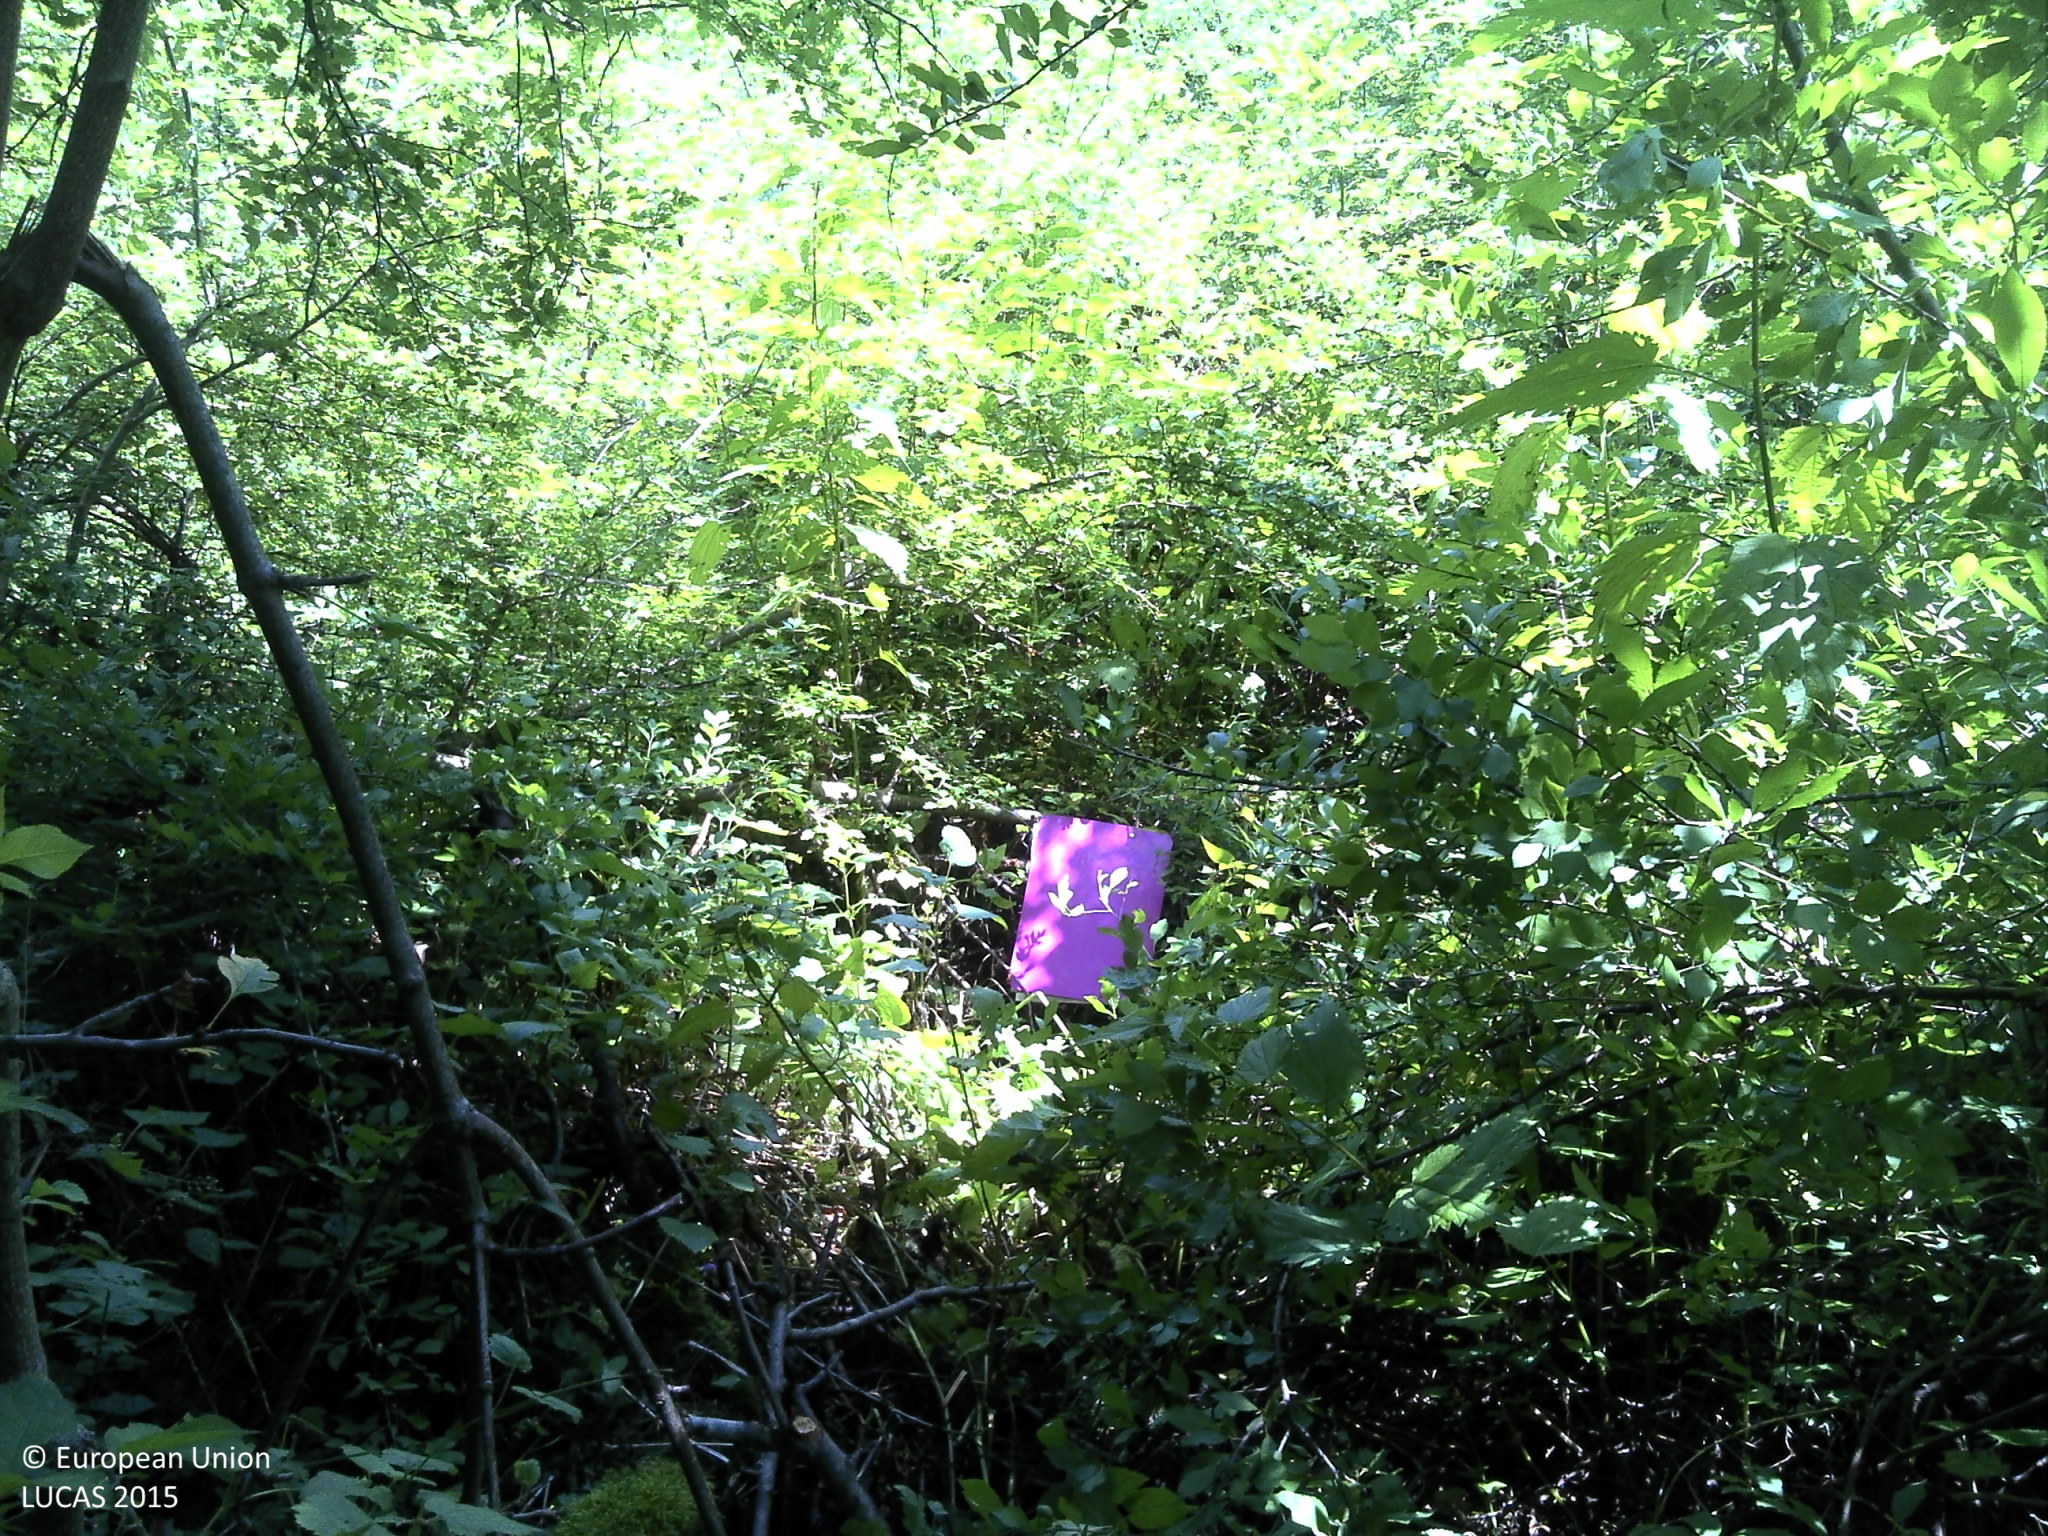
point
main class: Woodland
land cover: Broadleaved woodland
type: beech forest
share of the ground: > 75 %
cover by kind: broadleaved forest trees 75 %, shrubs 25 %
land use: Forestry
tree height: > 5 m
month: June
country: HR
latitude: 44.8459
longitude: 15.6753
